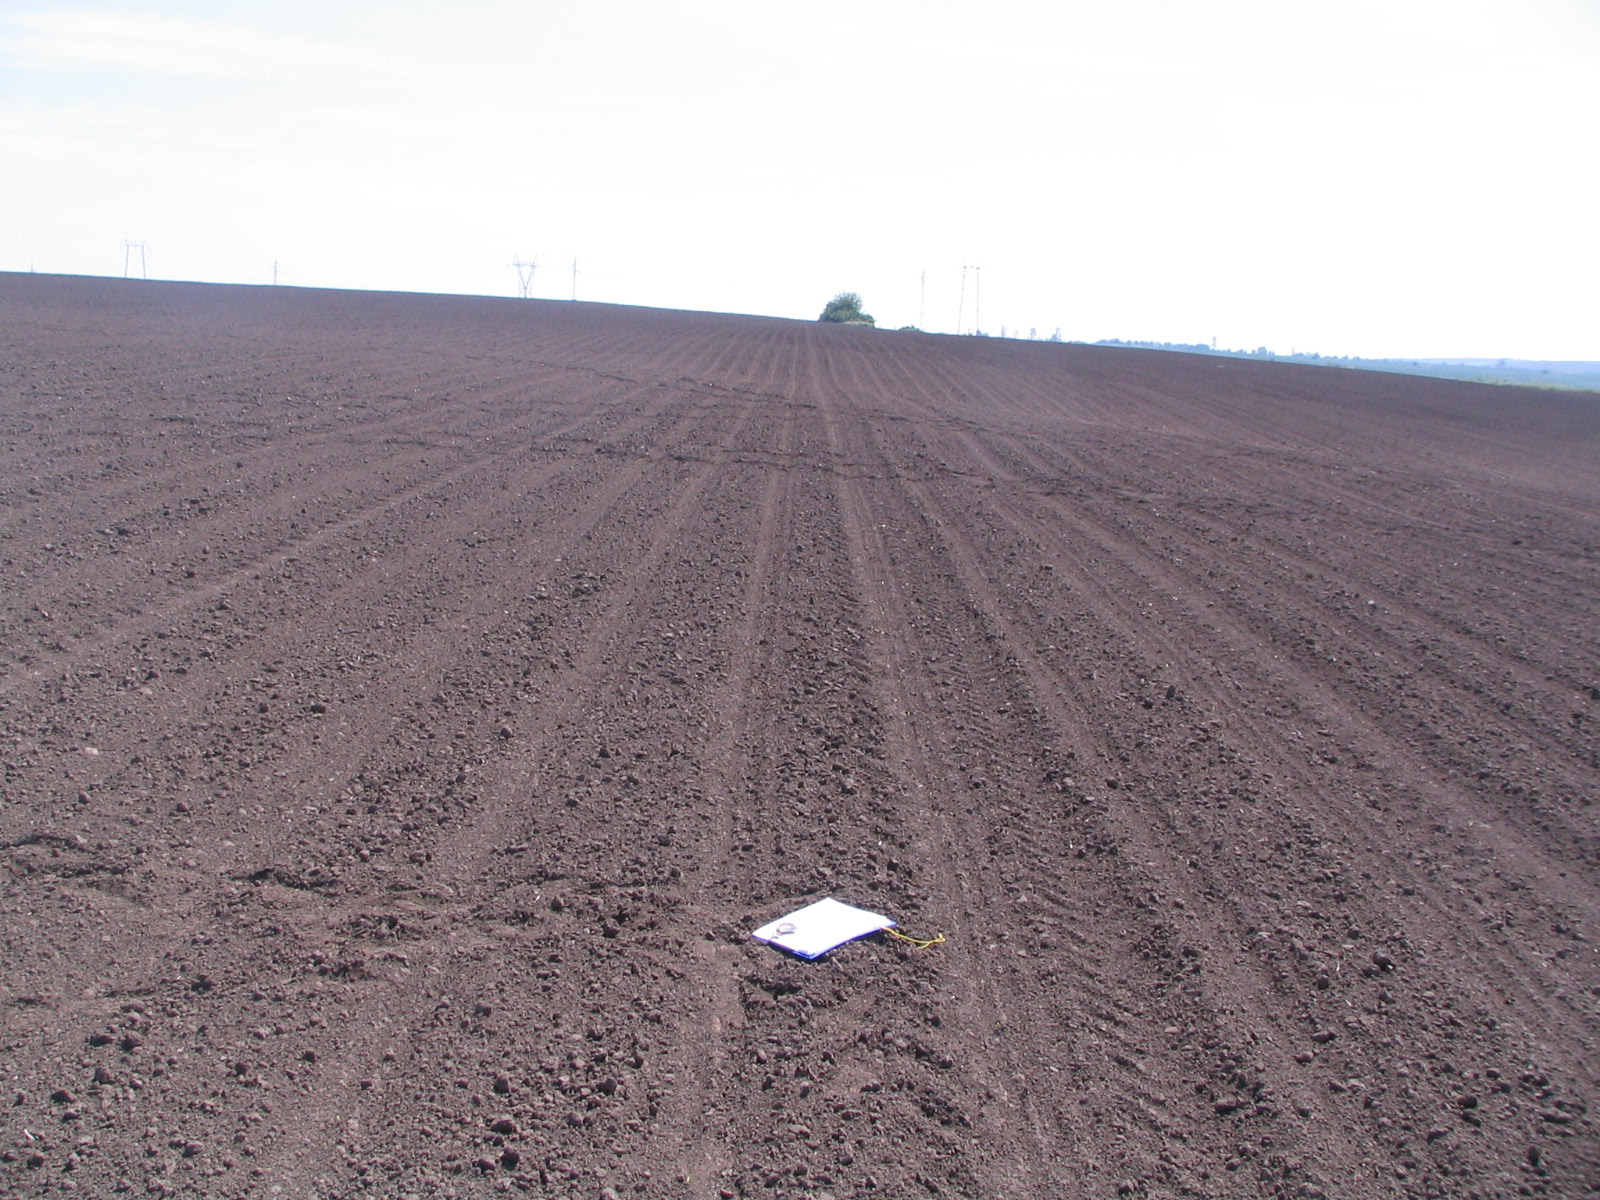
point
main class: Cropland
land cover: Maize
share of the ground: < 10 %
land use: Agriculture (excluding fallow land and kitchen gardens)
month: May
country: BG
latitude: 43.7181
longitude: 23.9179
